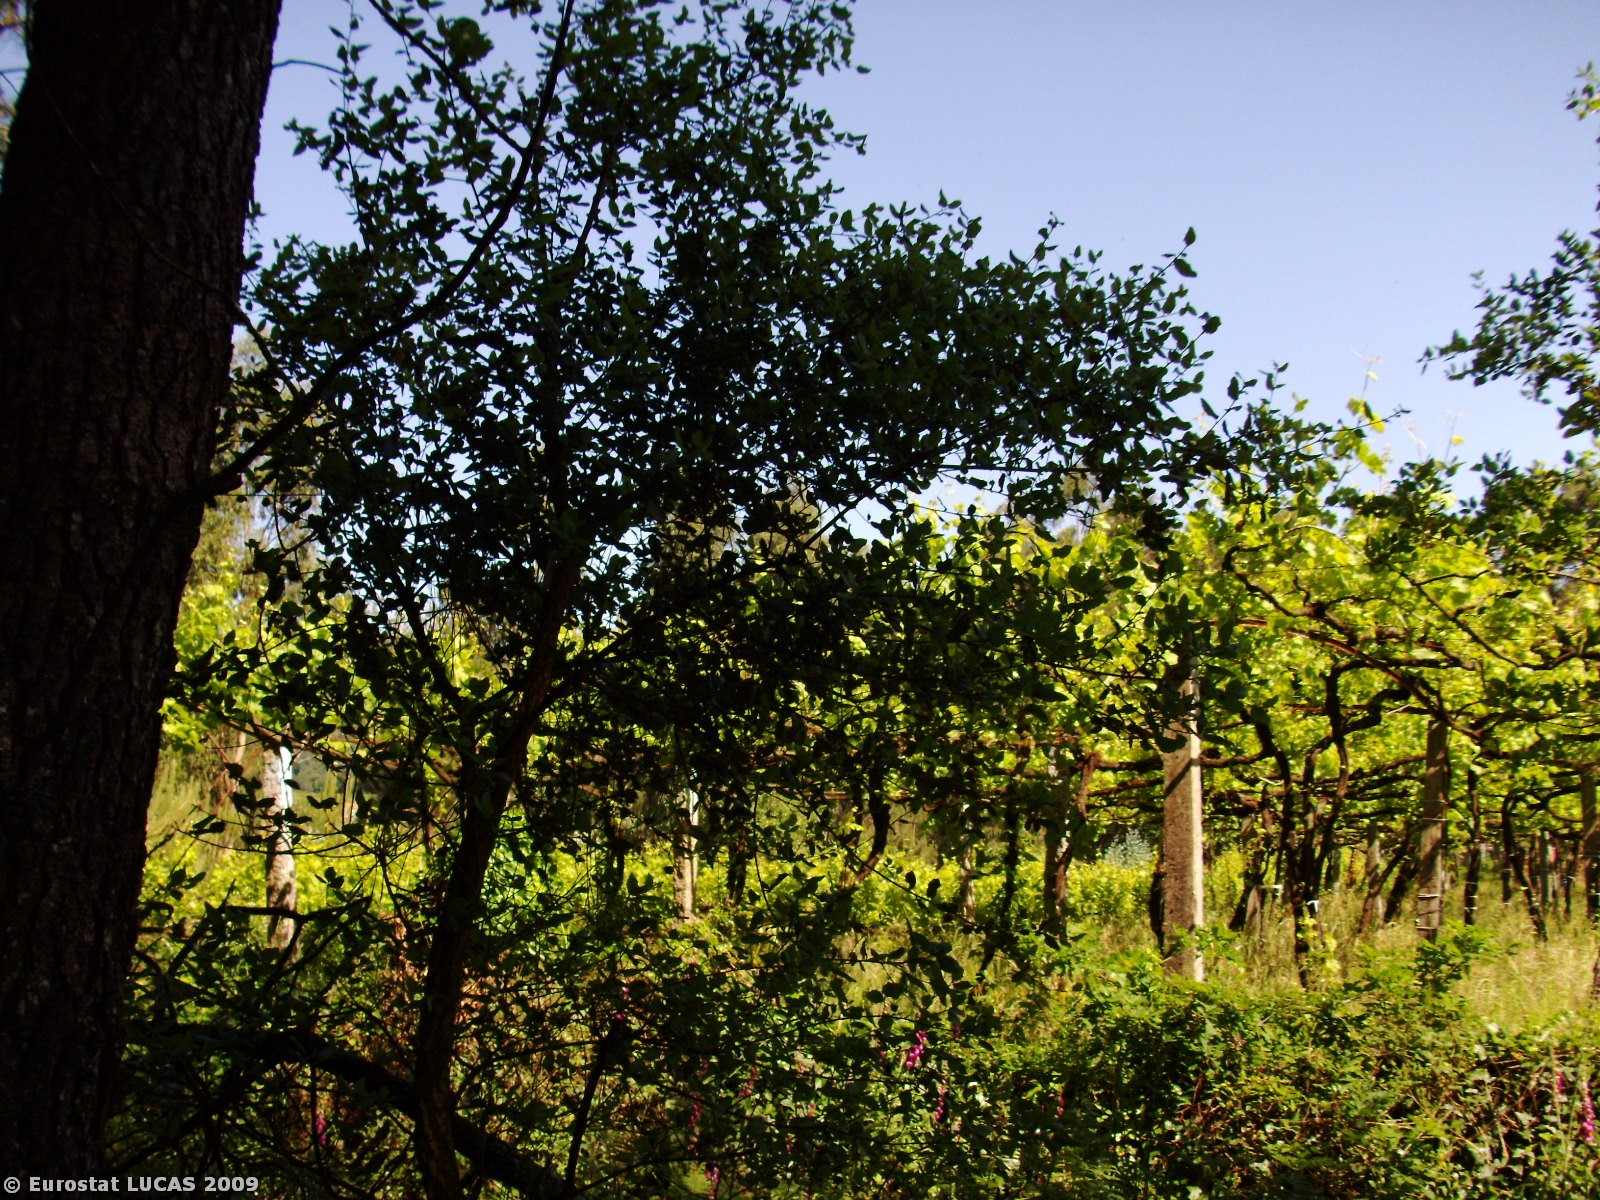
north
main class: Woodland
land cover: Mixed woodland
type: coniferous forest of the mediterranean region
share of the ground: > 75 %
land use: Forestry
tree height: > 5 m
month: May
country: PT
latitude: 41.5971
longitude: -8.5999
